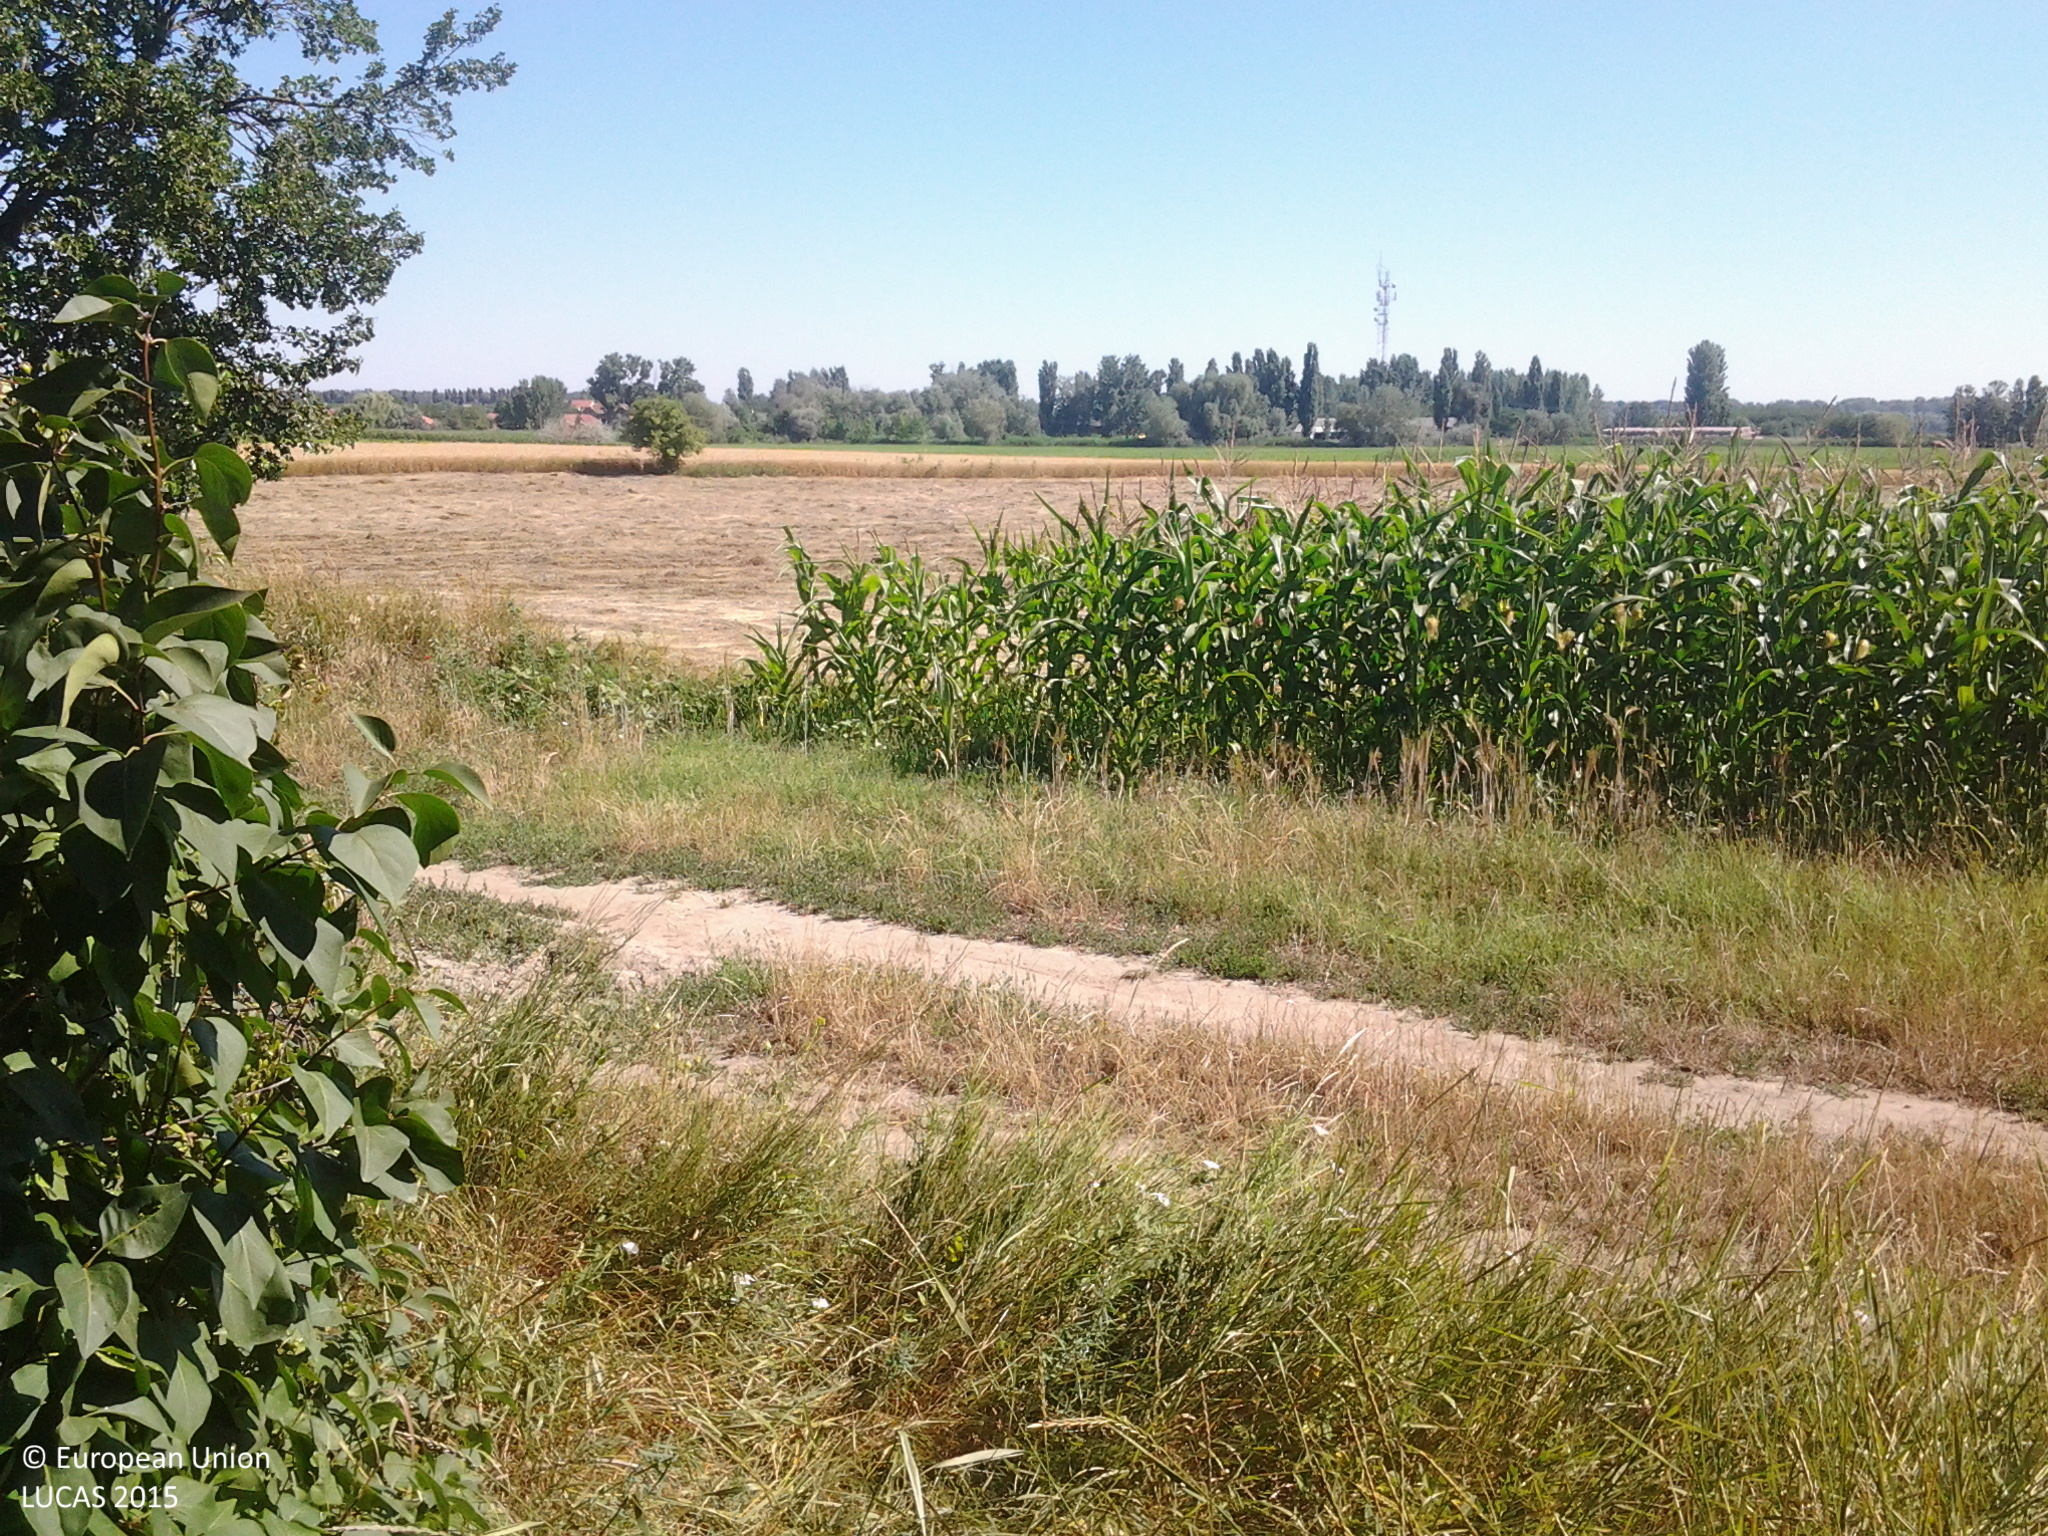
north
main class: Grassland
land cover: Grassland with sparse tree/shrub cover
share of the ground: > 75 %
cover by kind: herbaceous plants 90 %, broadleaved forest trees 5 %, shrubs 5 %
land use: Semi-natural and natural areas not in use
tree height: < 5 m
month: July
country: HU
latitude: 46.9221
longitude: 20.1233
